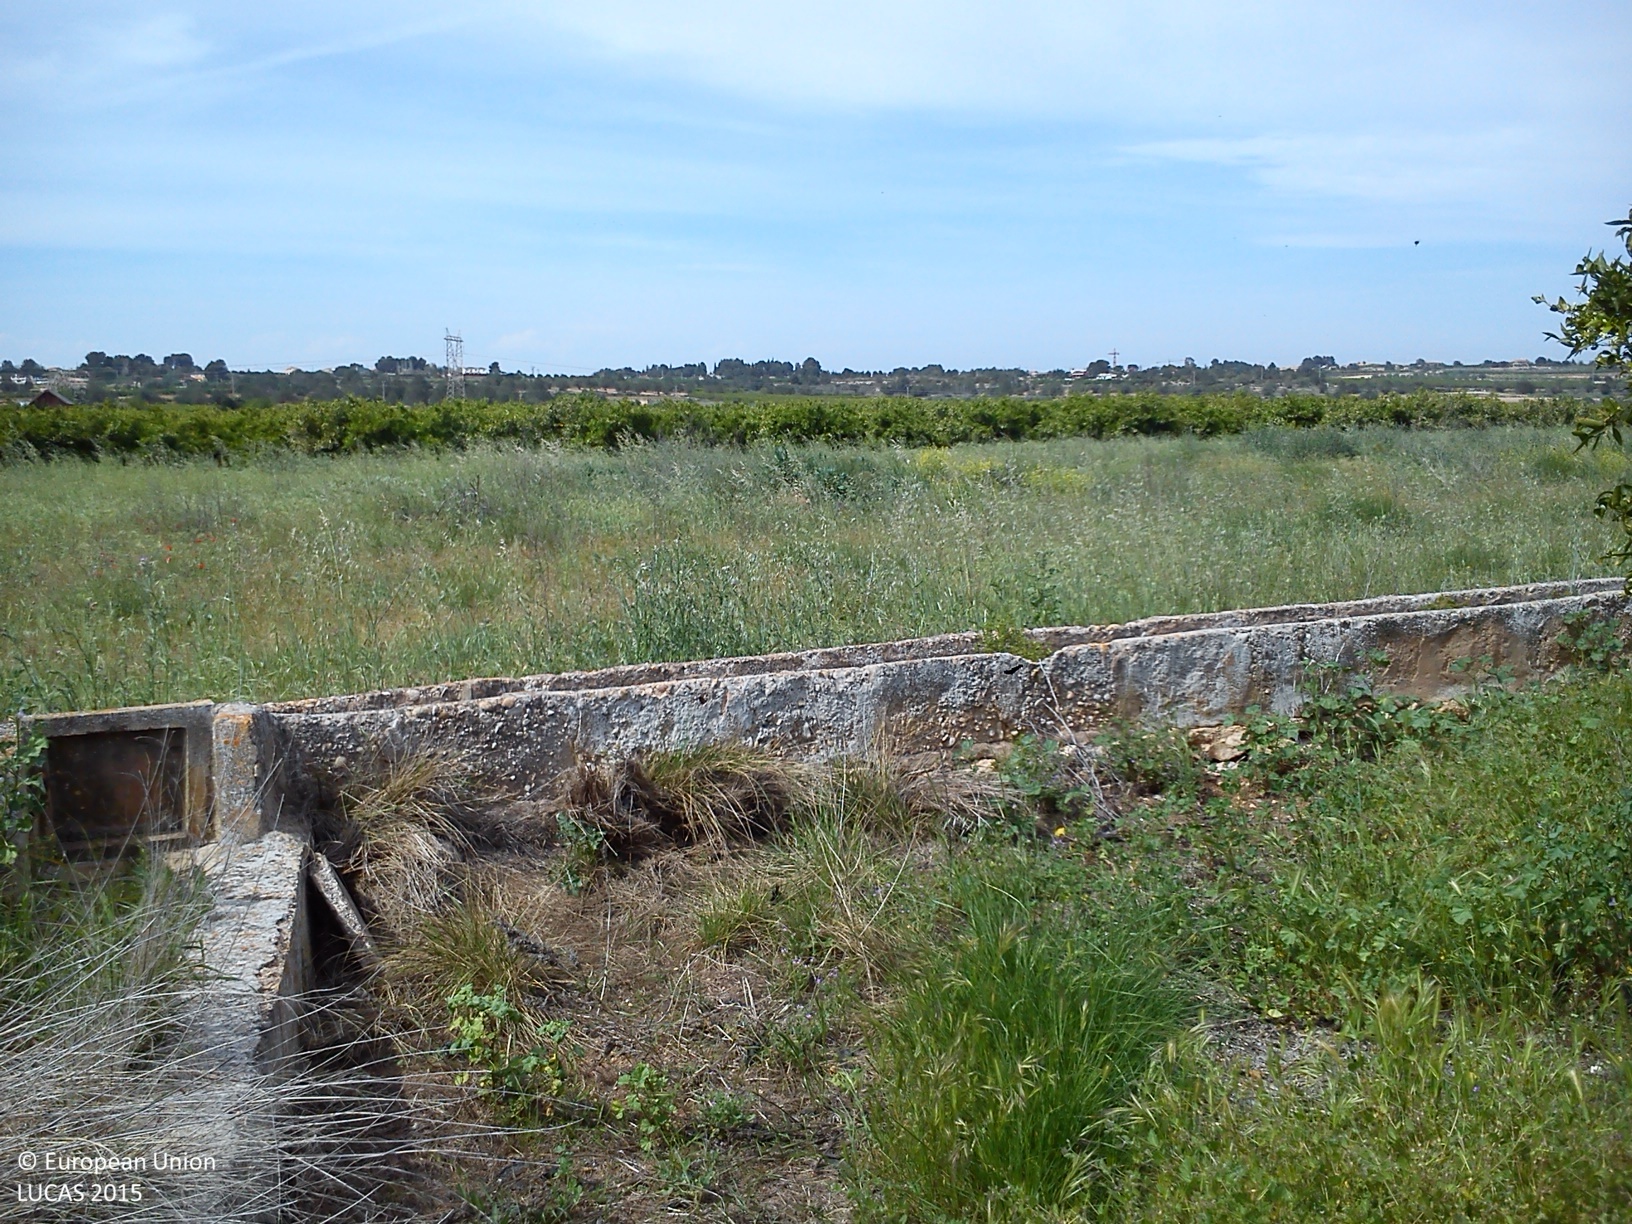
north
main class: Cropland
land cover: Oranges
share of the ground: > 75 %
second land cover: Spontaneously vegetated surfaces
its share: < 10 %
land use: Agriculture (excluding fallow land and kitchen gardens)
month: April
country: ES
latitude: 39.3946
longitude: -0.6454
